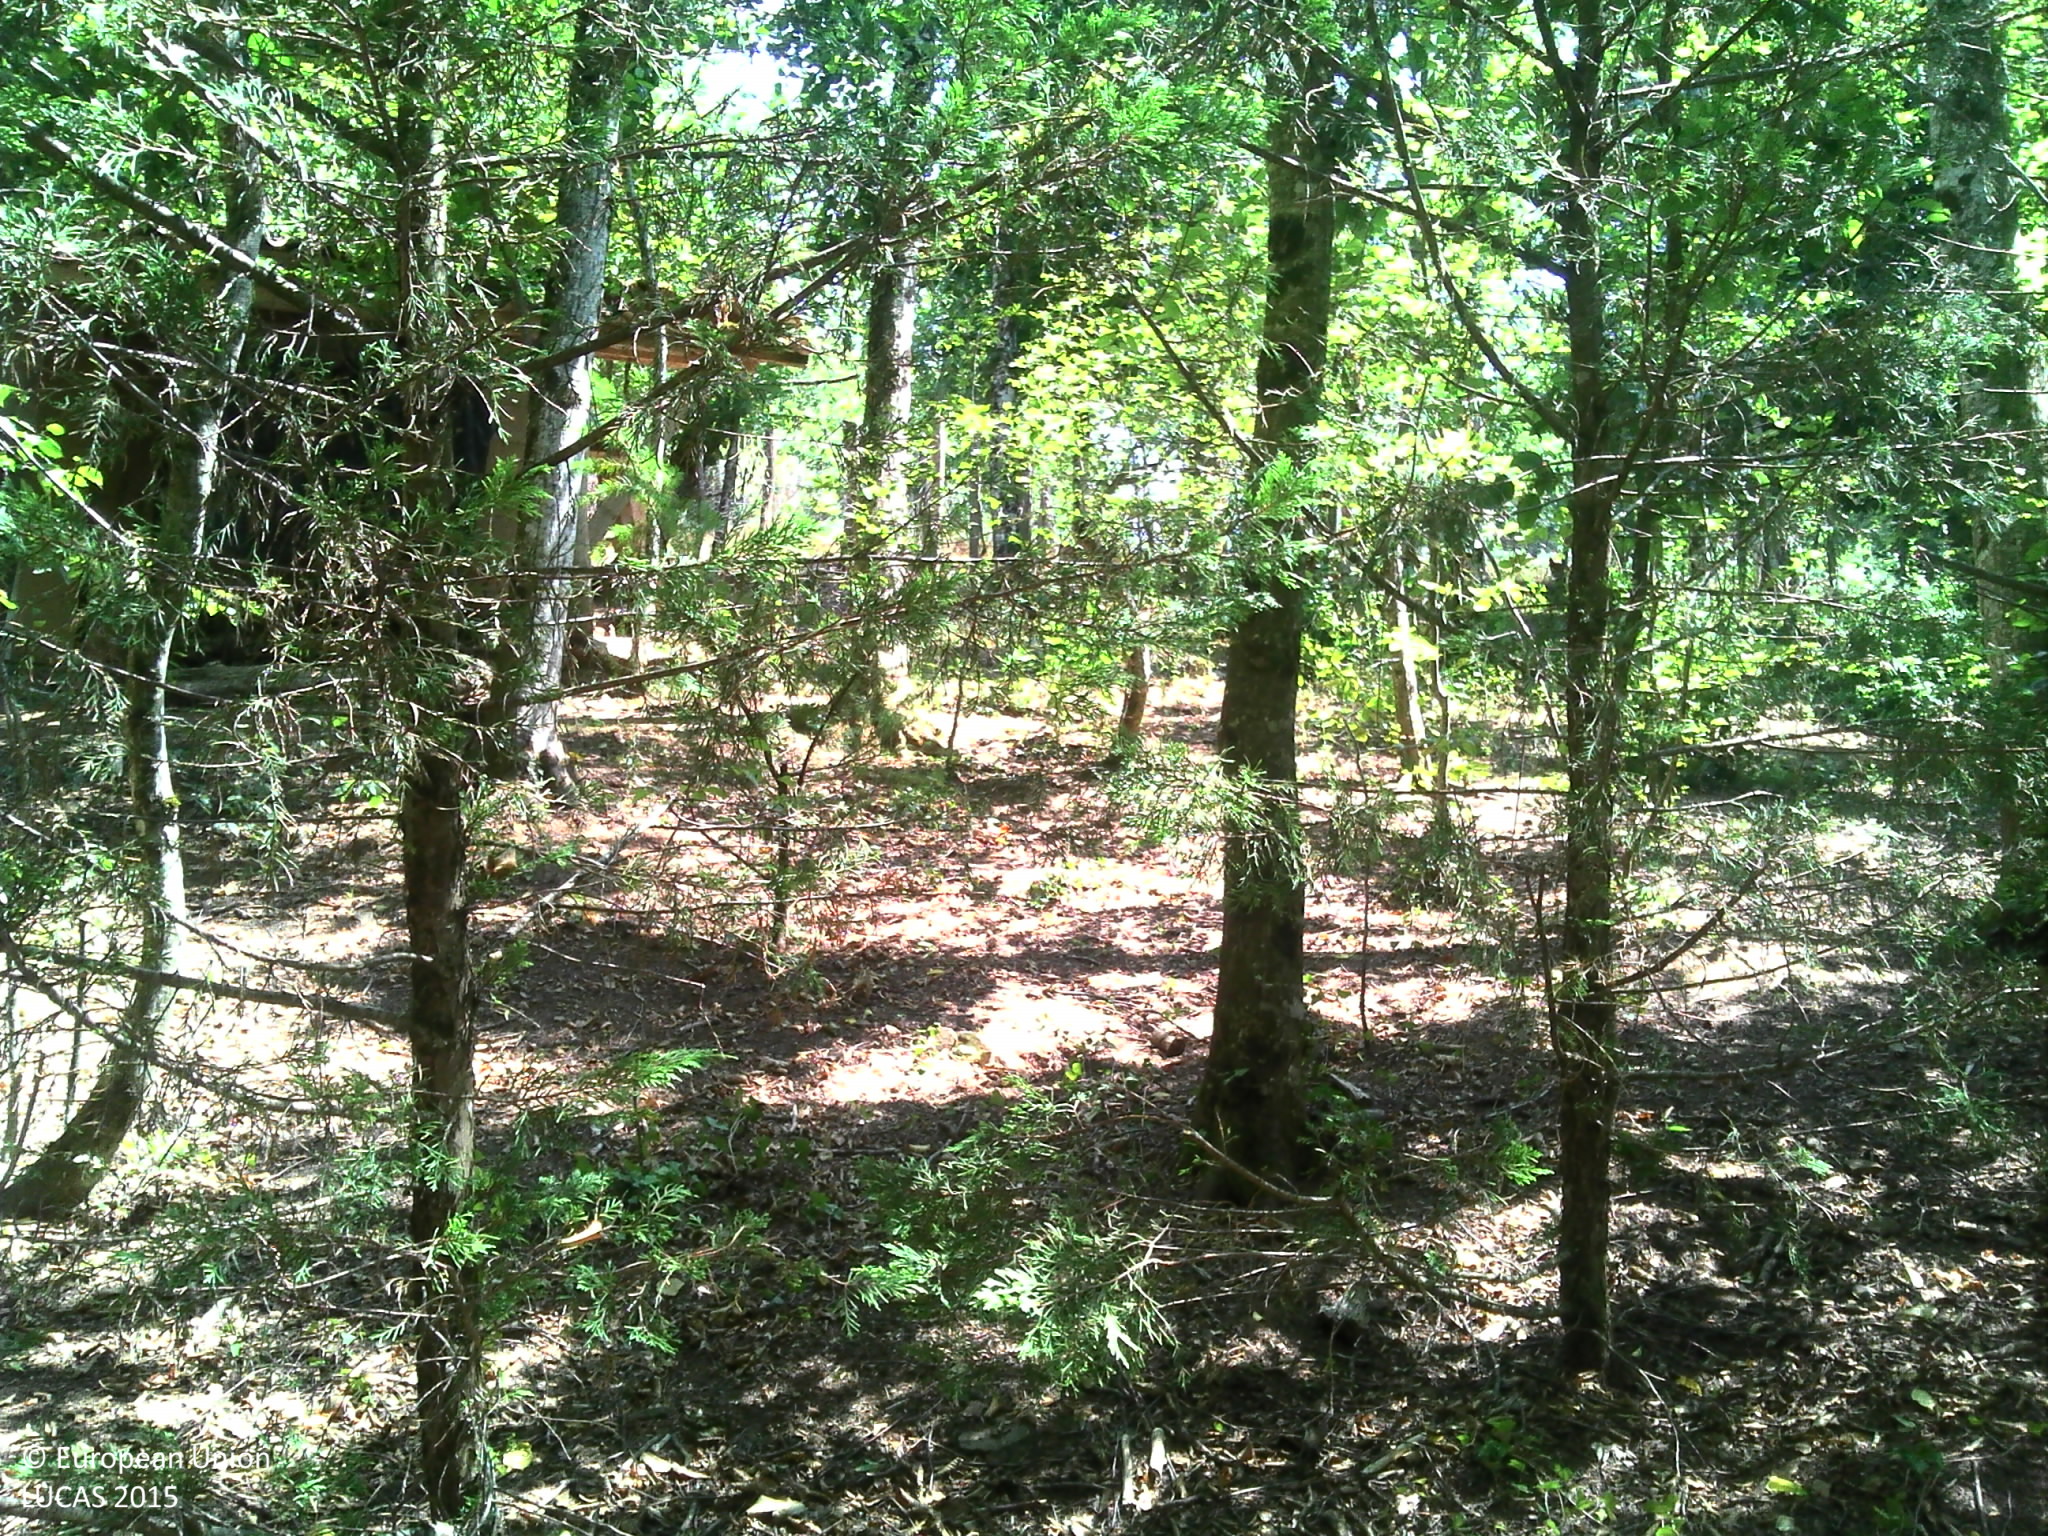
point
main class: Woodland
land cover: Broadleaved woodland
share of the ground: > 75 %
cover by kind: broadleaved forest trees 75 %, herbaceous plants 20 %, coniferous forest trees 5 %
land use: Residential
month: August
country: FR
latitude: 45.2378
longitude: 1.7798
